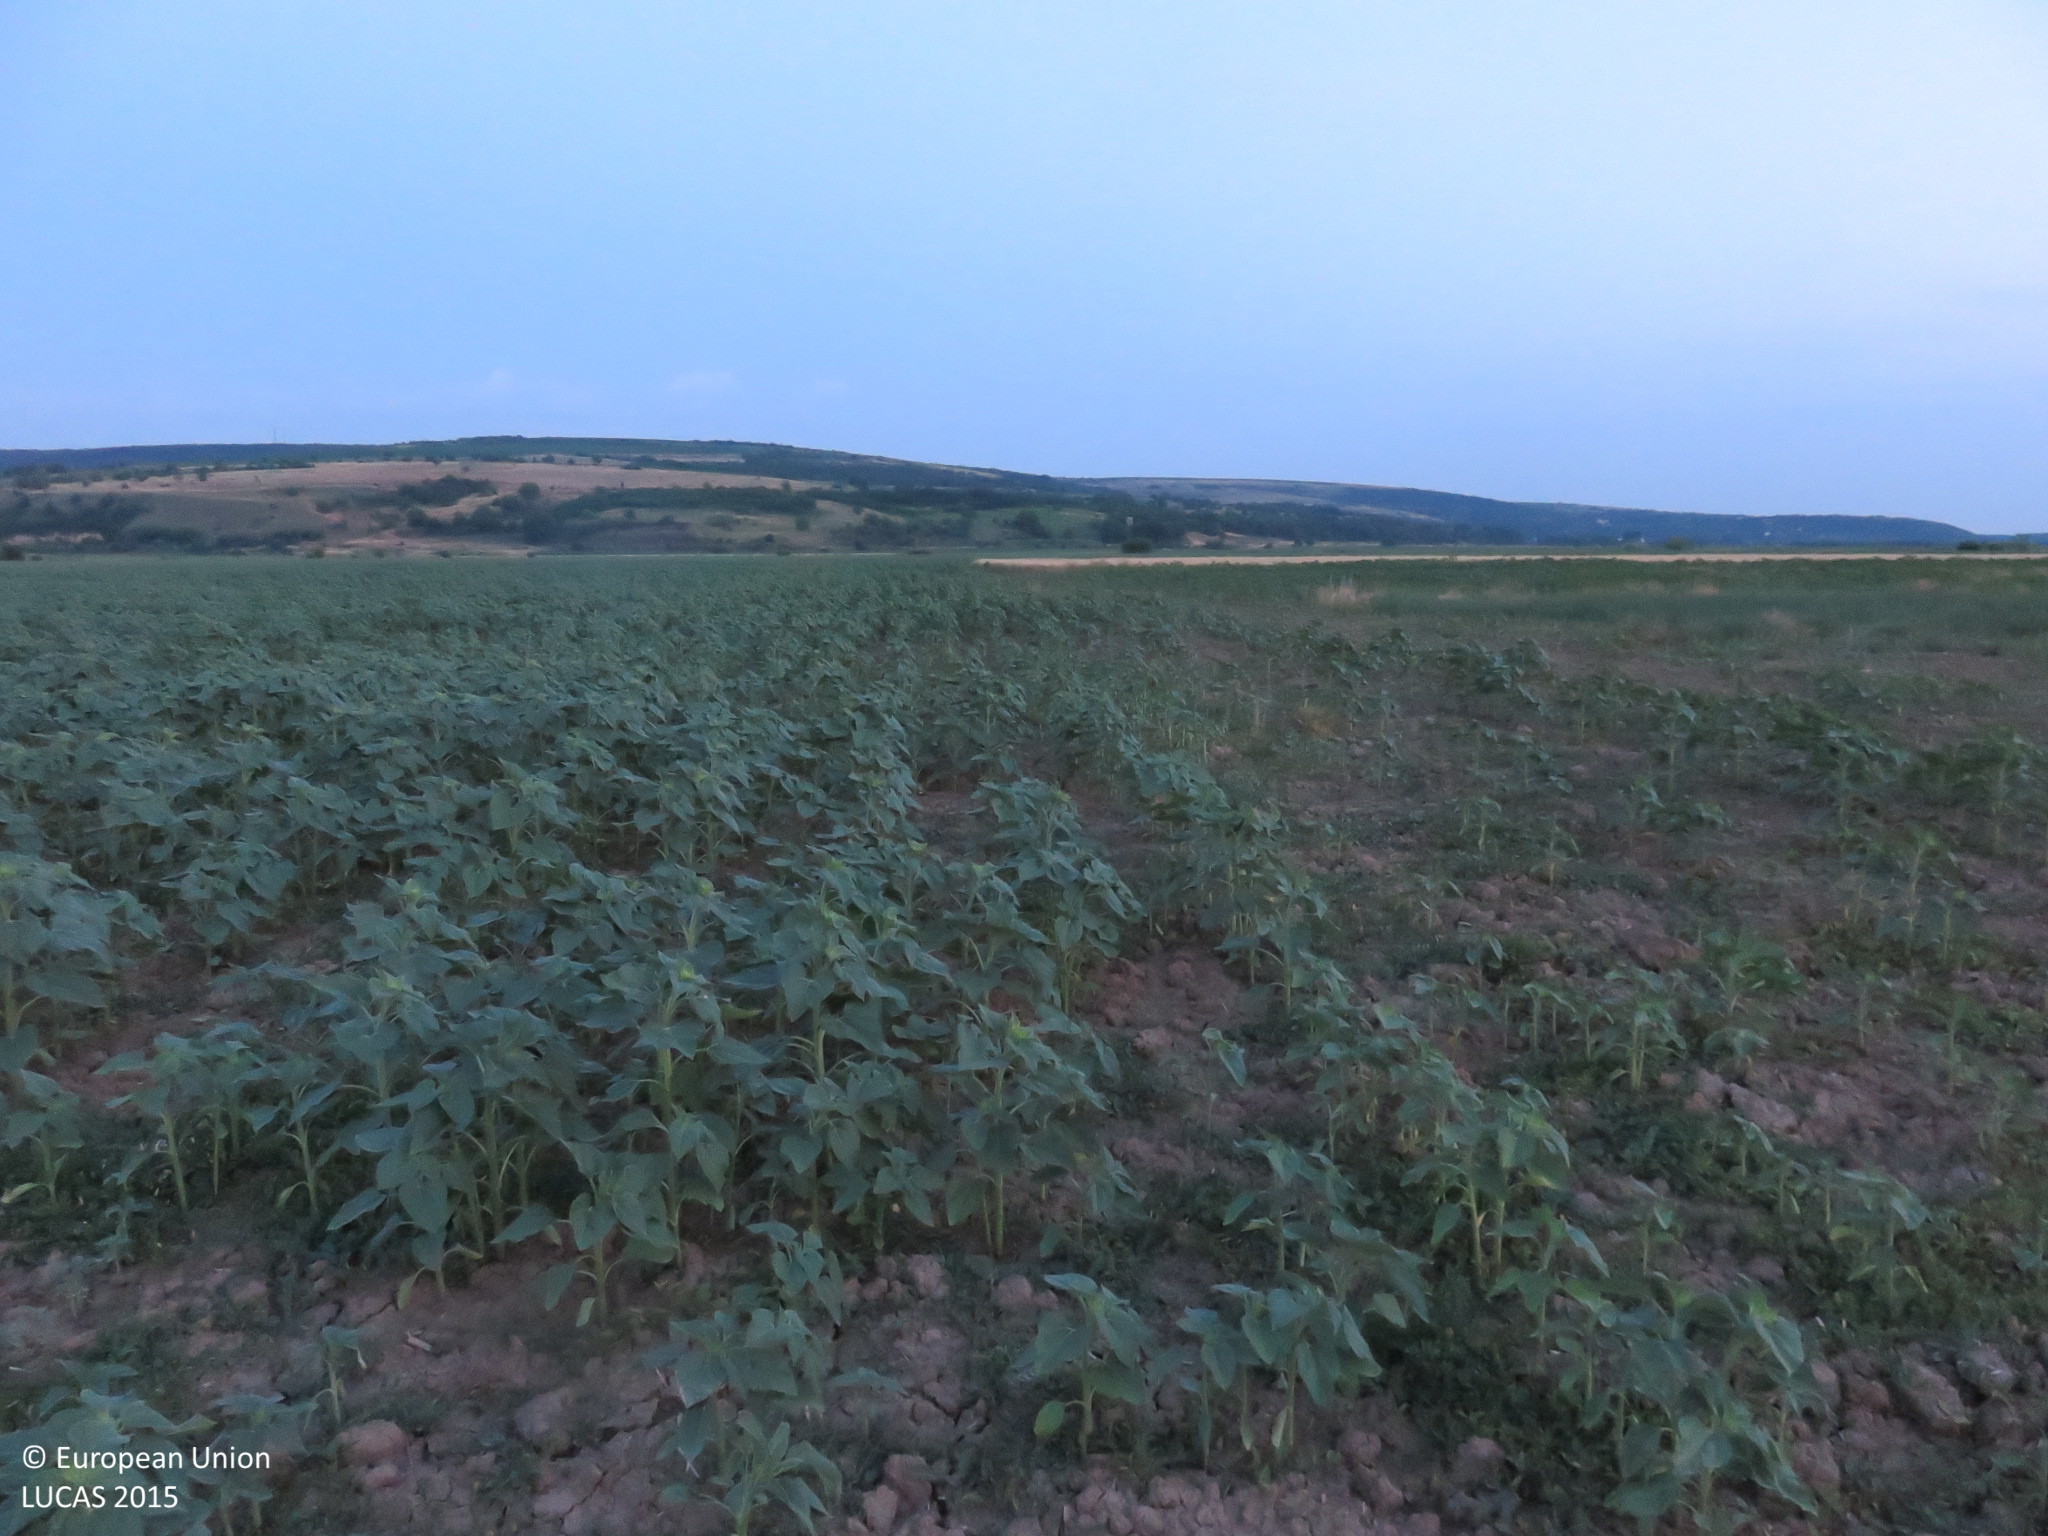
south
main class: Cropland
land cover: Sunflower
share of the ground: > 75 %
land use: Agriculture (excluding fallow land and kitchen gardens)
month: June
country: BG
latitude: 43.6963
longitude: 24.4684
